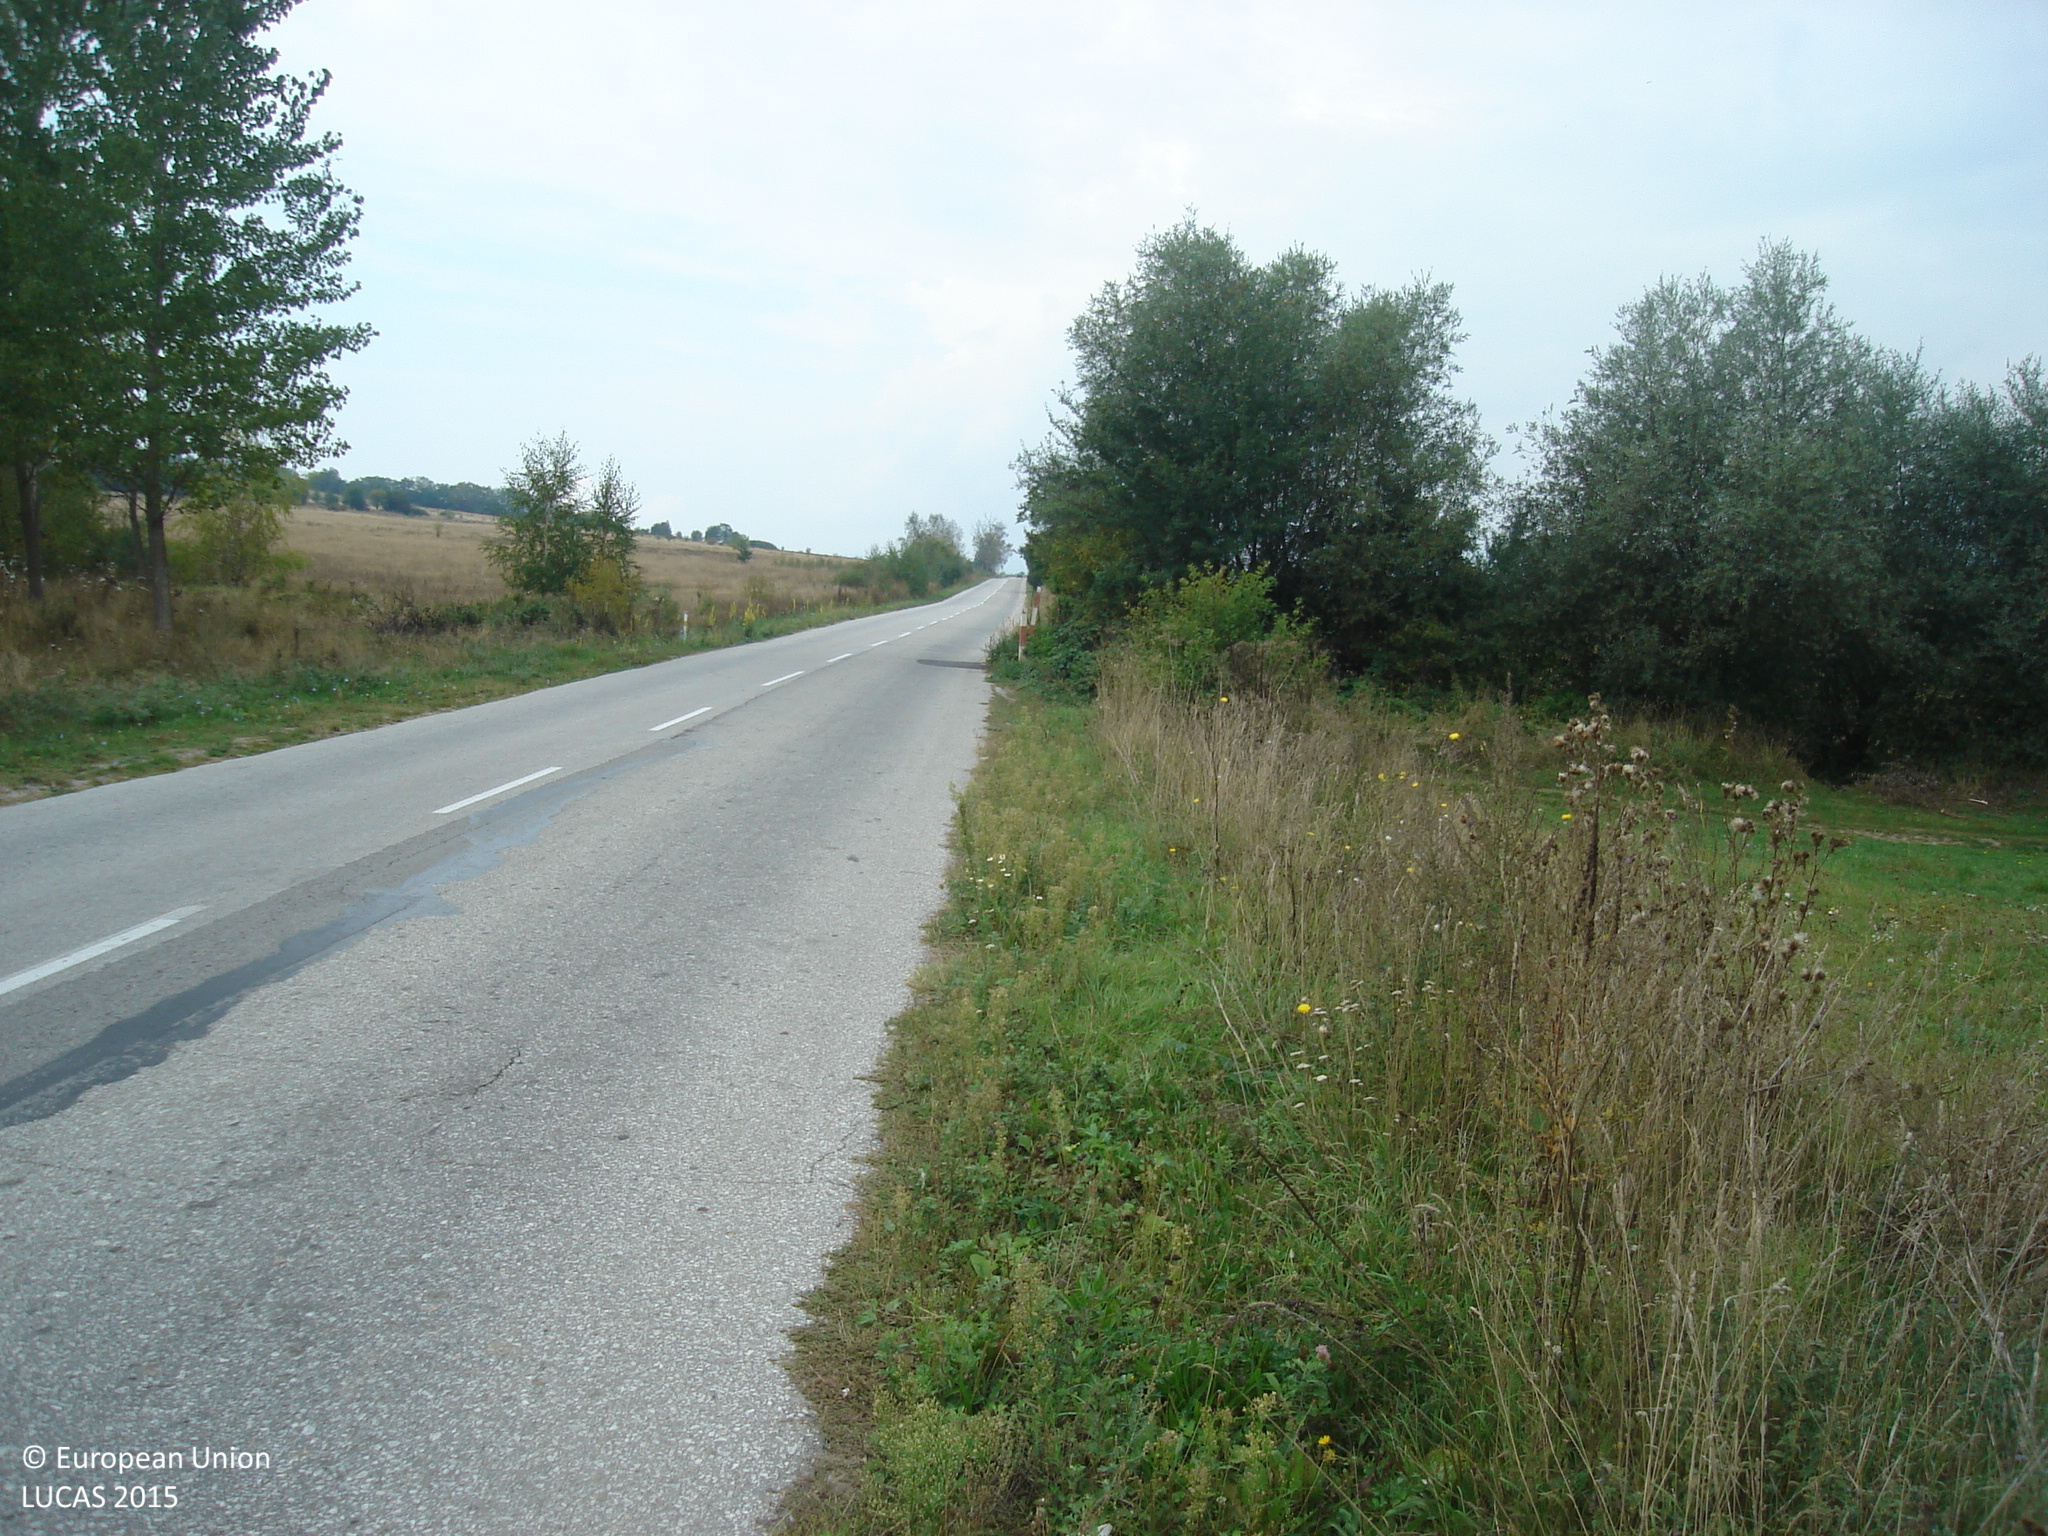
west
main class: Grassland
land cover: Grassland without tree/shrub cover
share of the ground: > 75 %
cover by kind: herbaceous plants 100 %
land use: Road transport
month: September
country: BG
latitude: 42.7063
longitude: 24.2229
